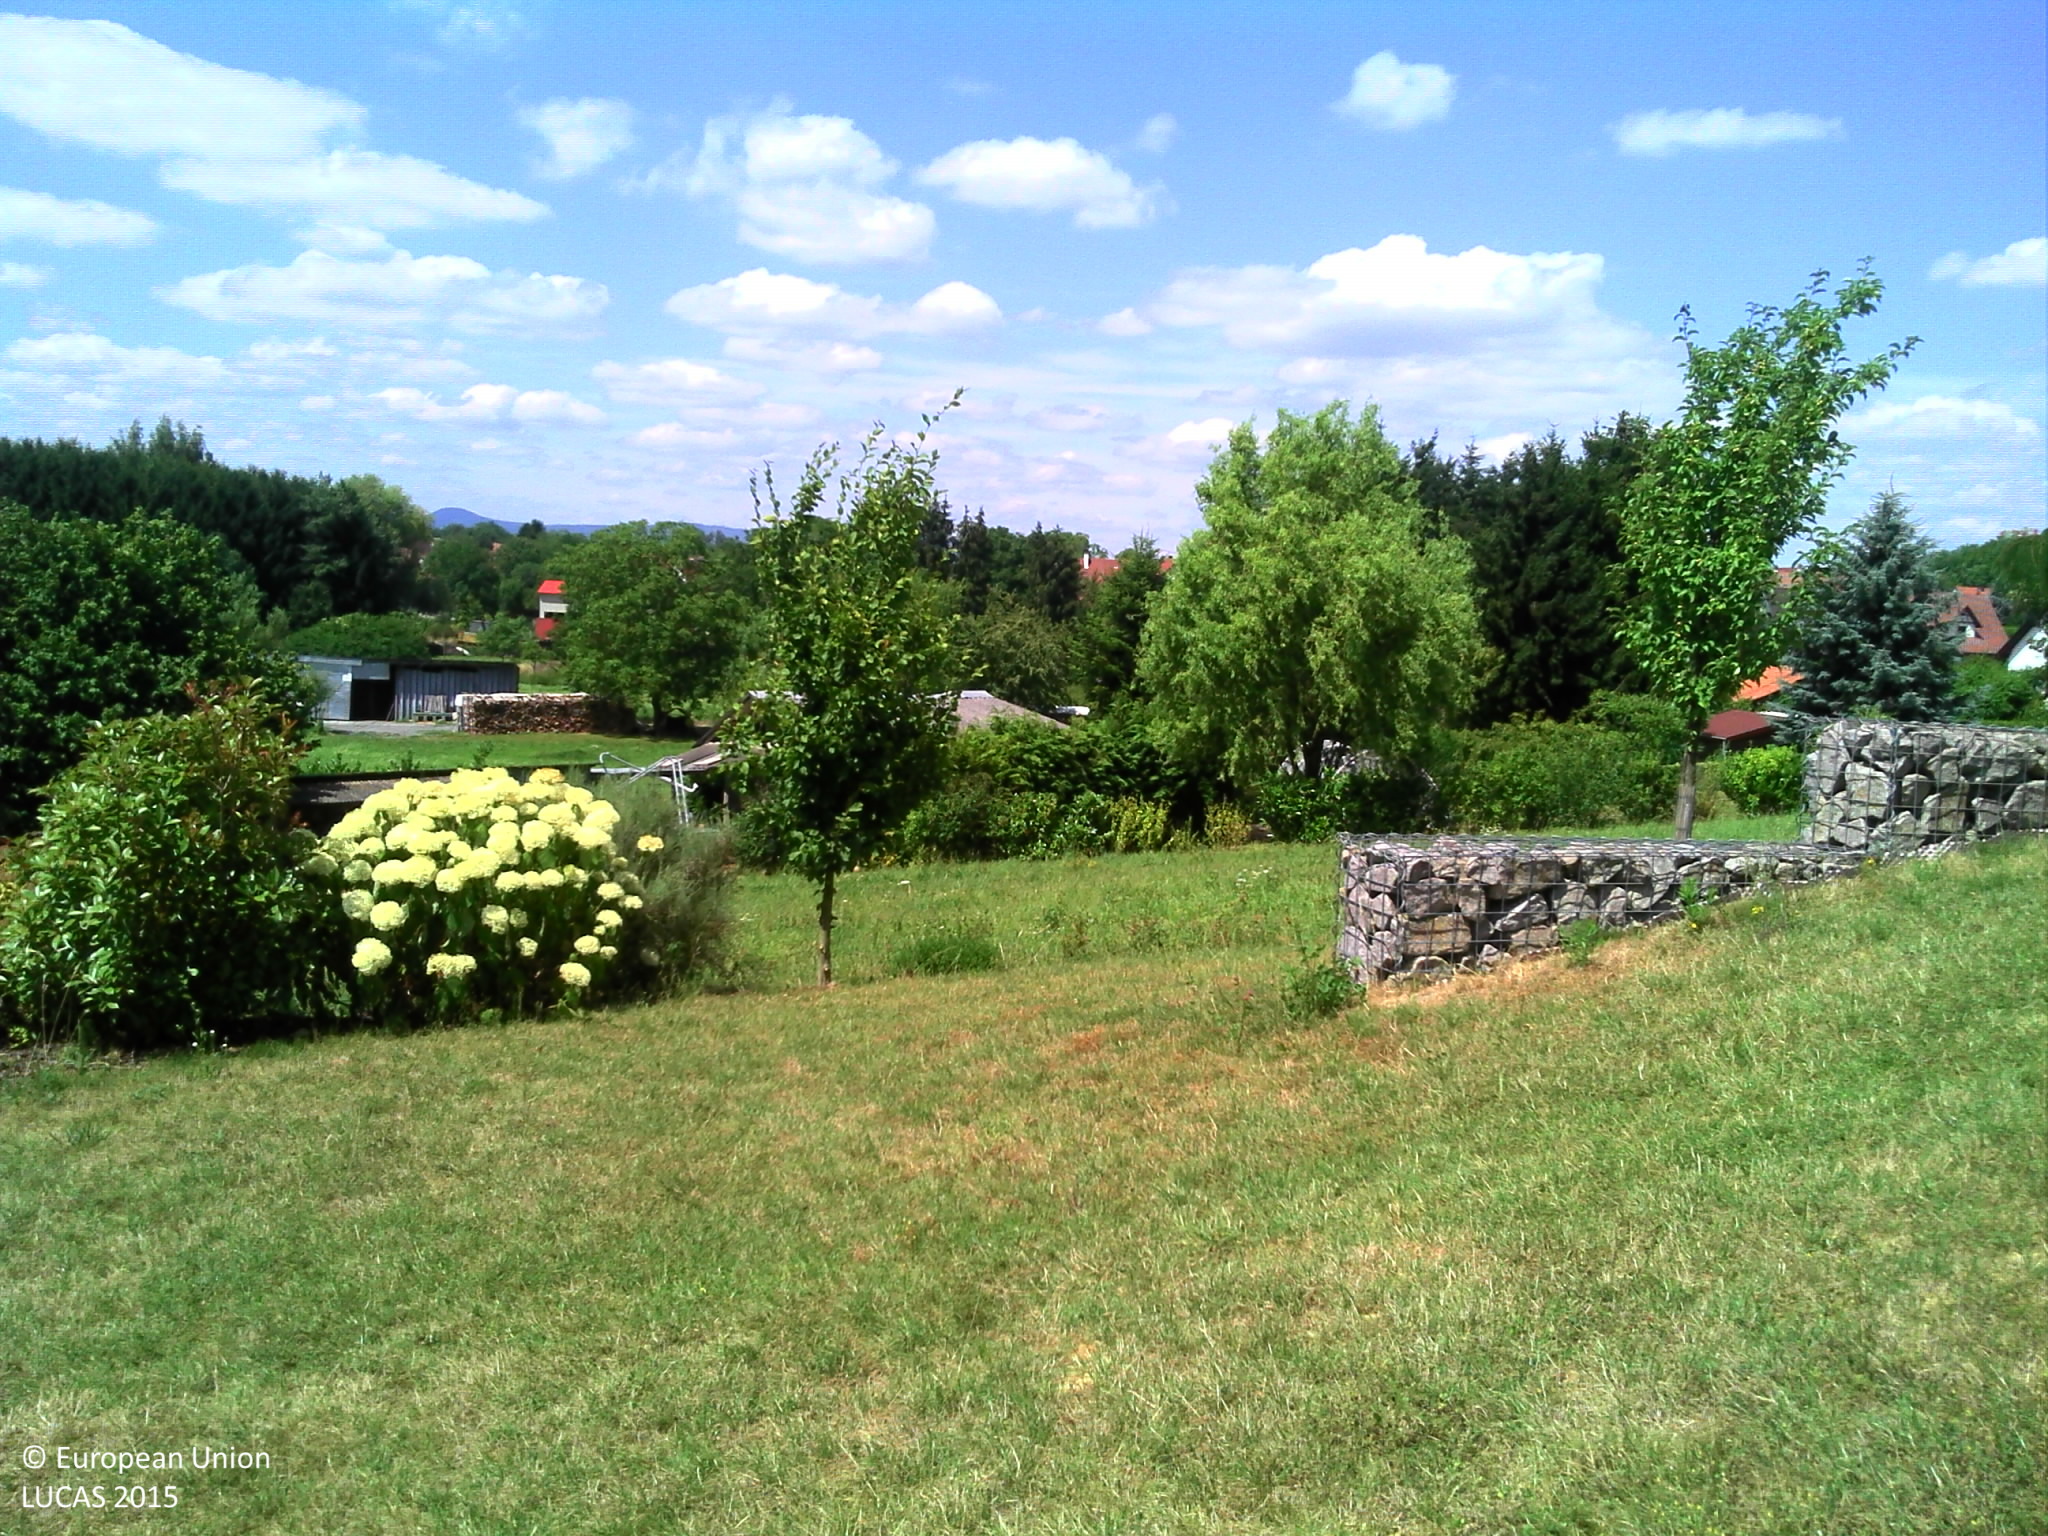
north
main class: Grassland
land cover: Grassland without tree/shrub cover
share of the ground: > 75 %
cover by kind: herbaceous plants 100 %
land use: Residential
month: July
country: FR
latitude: 48.9612
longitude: 7.9929
